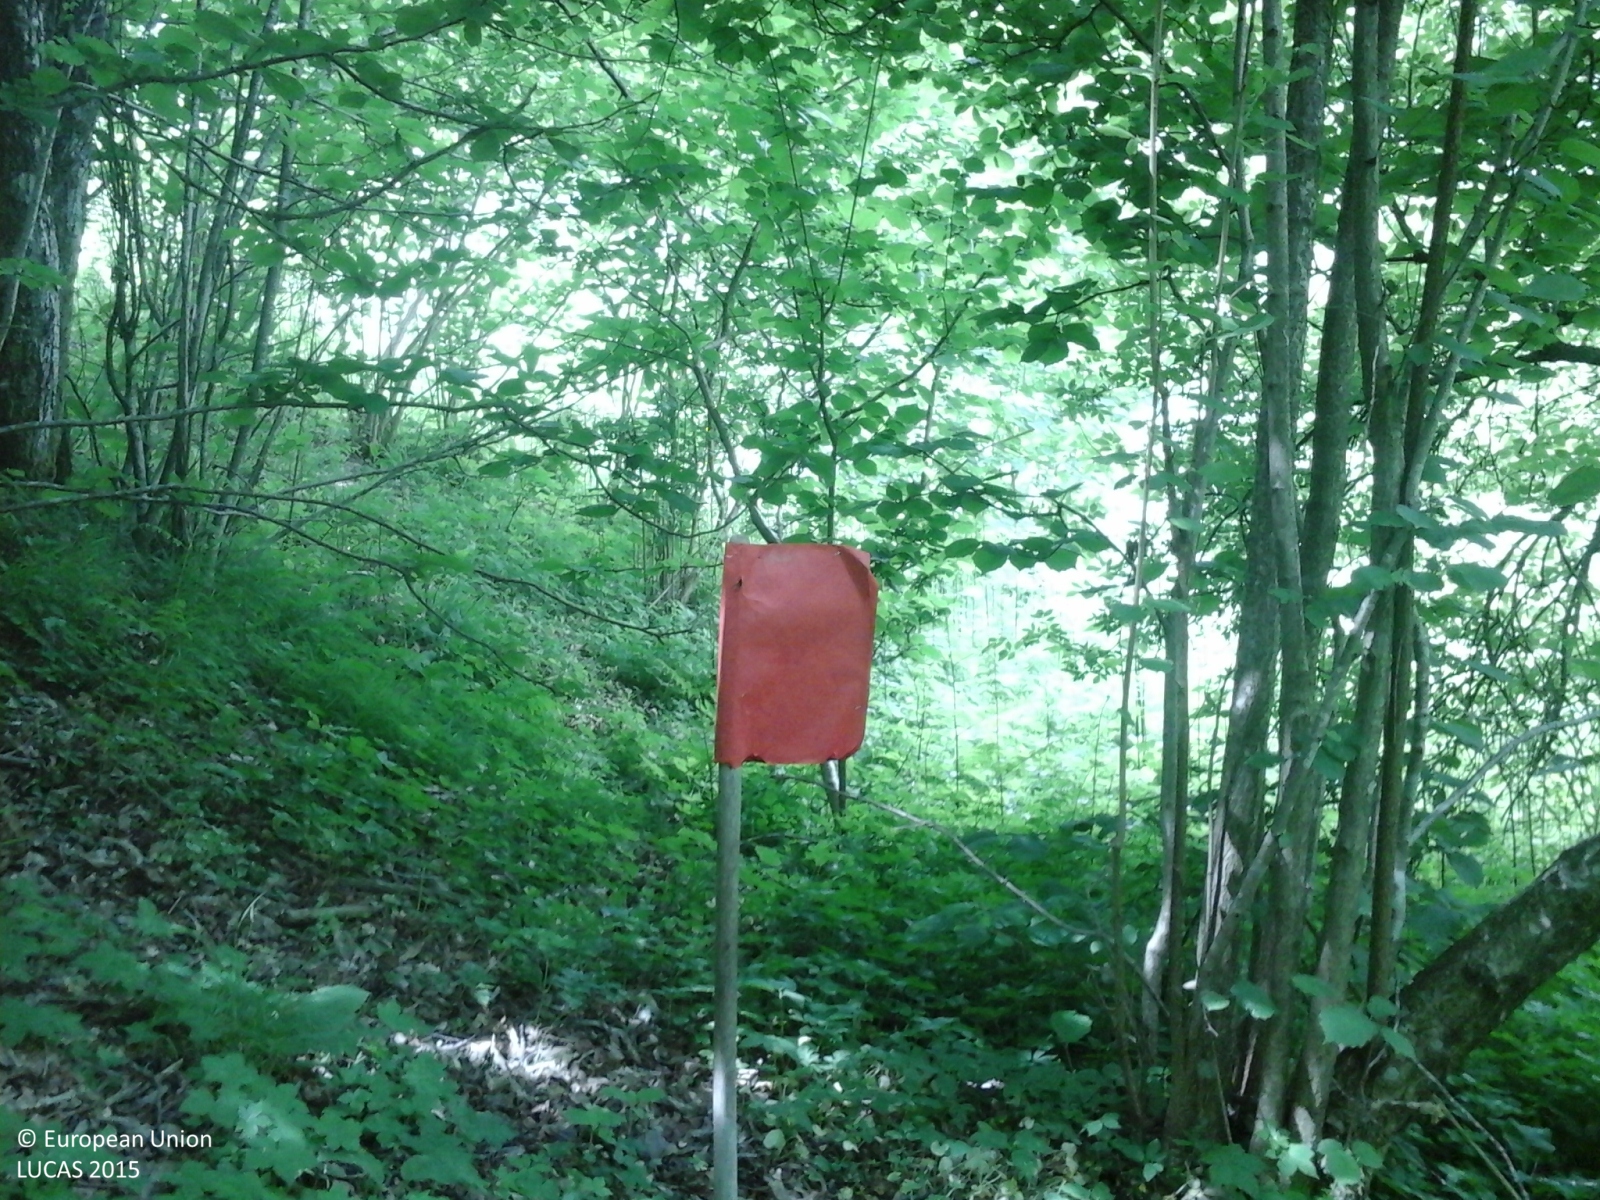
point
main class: Woodland
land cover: Broadleaved woodland
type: thermophilous deciduous forest
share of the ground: > 75 %
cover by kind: broadleaved forest trees 80 %, herbaceous plants 20 %
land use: Forestry
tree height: > 5 m
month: May
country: IT
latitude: 44.4222
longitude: 9.6867
